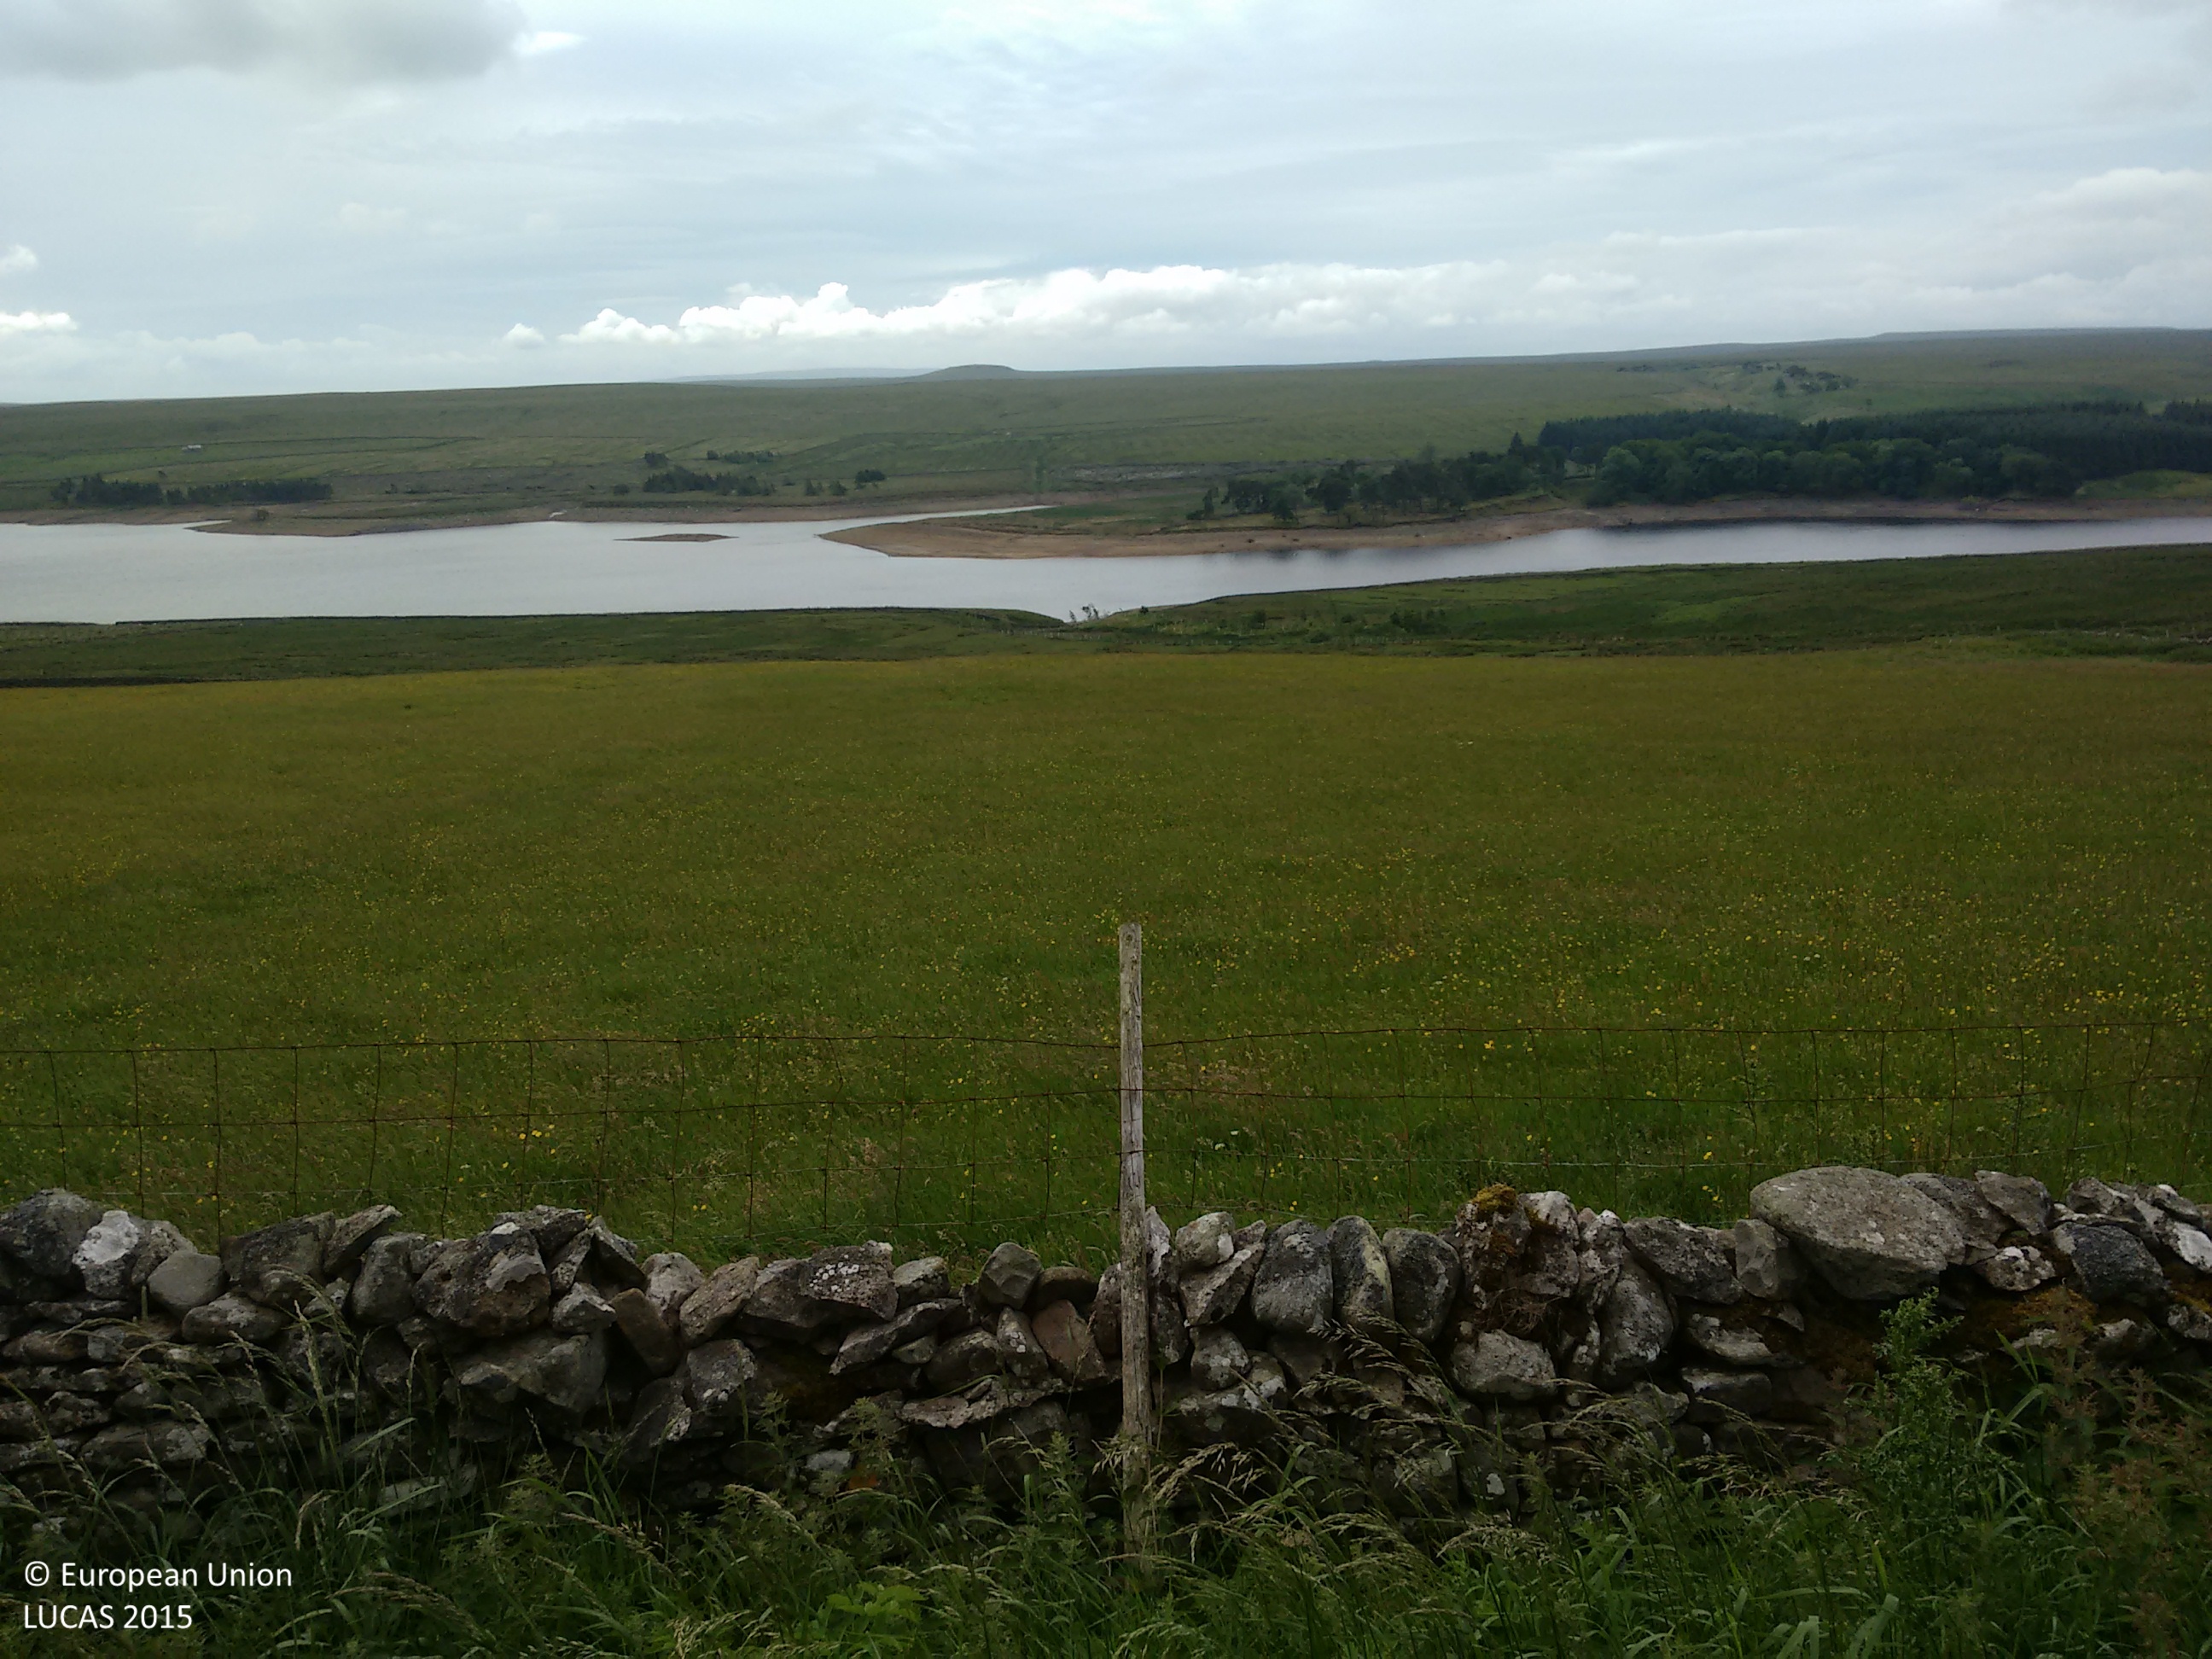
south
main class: Grassland
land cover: Grassland without tree/shrub cover
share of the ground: > 75 %
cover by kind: herbaceous plants 100 %
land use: Water supply and treatment
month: July
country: GB
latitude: 54.5892
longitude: -2.1439
